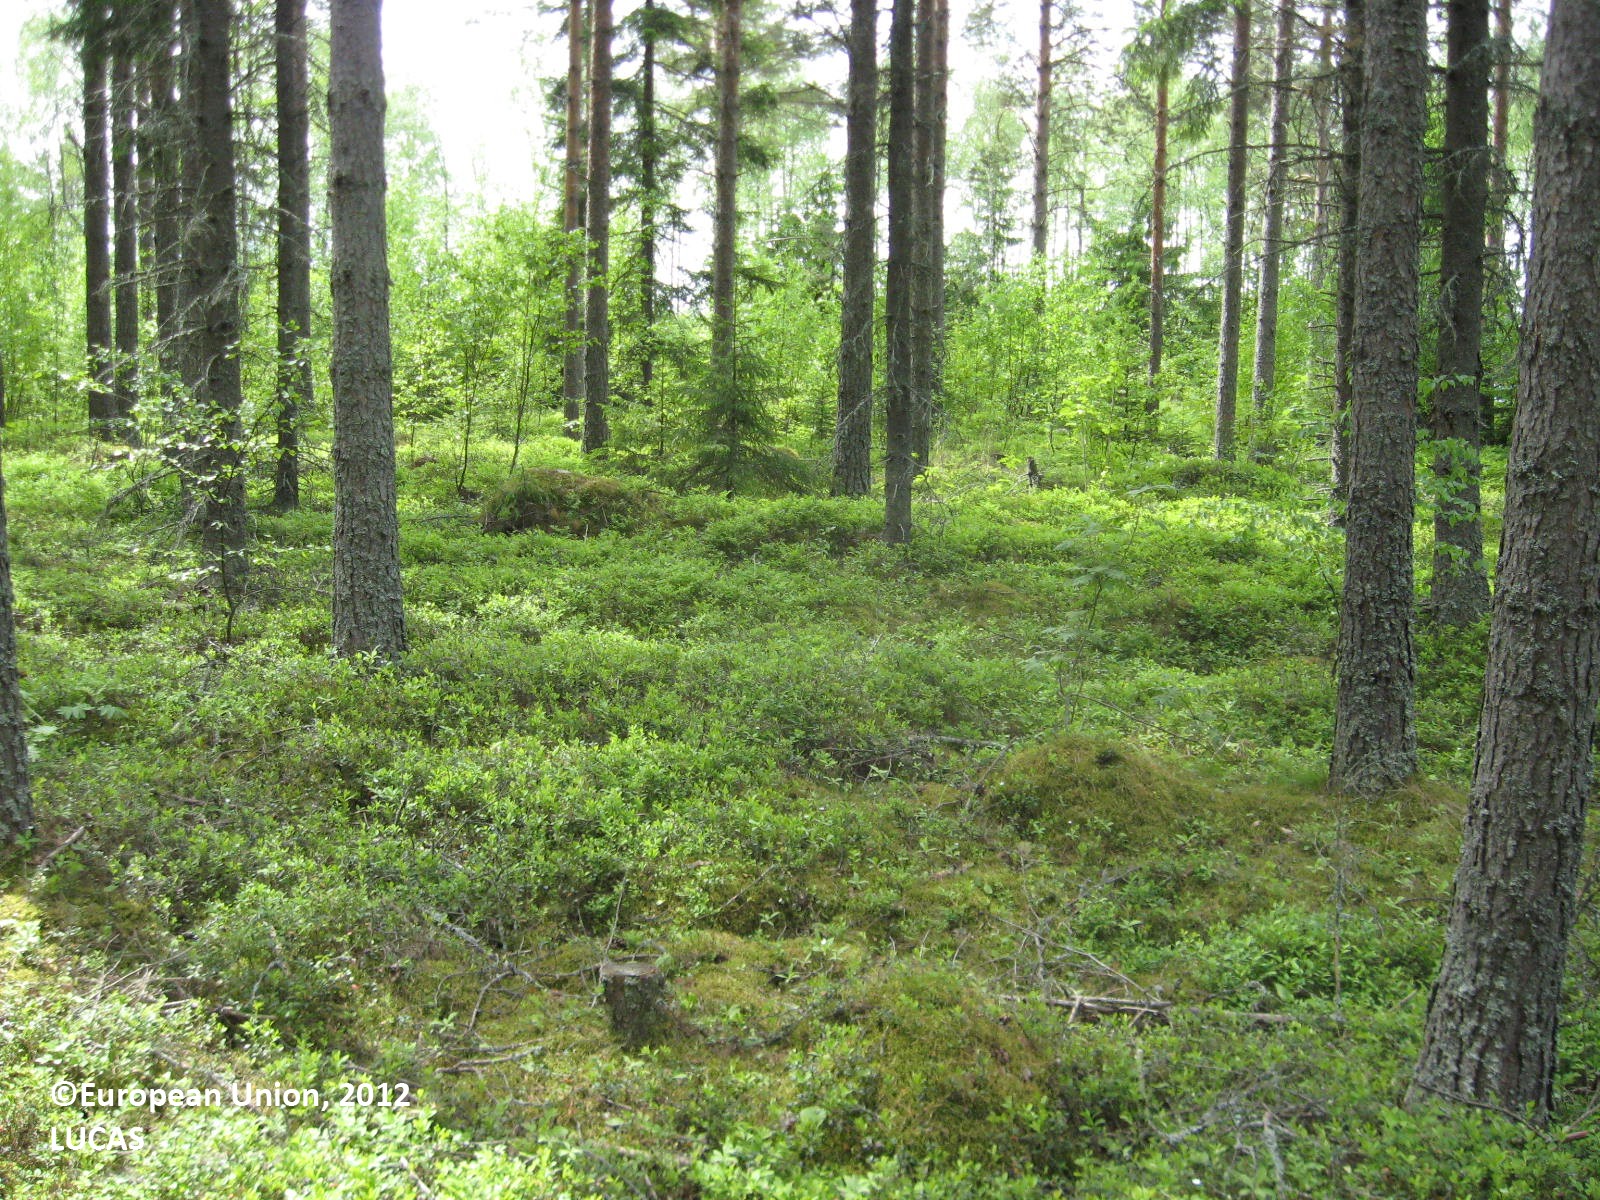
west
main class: Woodland
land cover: Other coniferous woodland
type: boreal forest
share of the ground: > 75 %
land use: Forestry
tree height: > 5 m
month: June
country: FI
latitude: 62.6388
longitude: 21.0965
